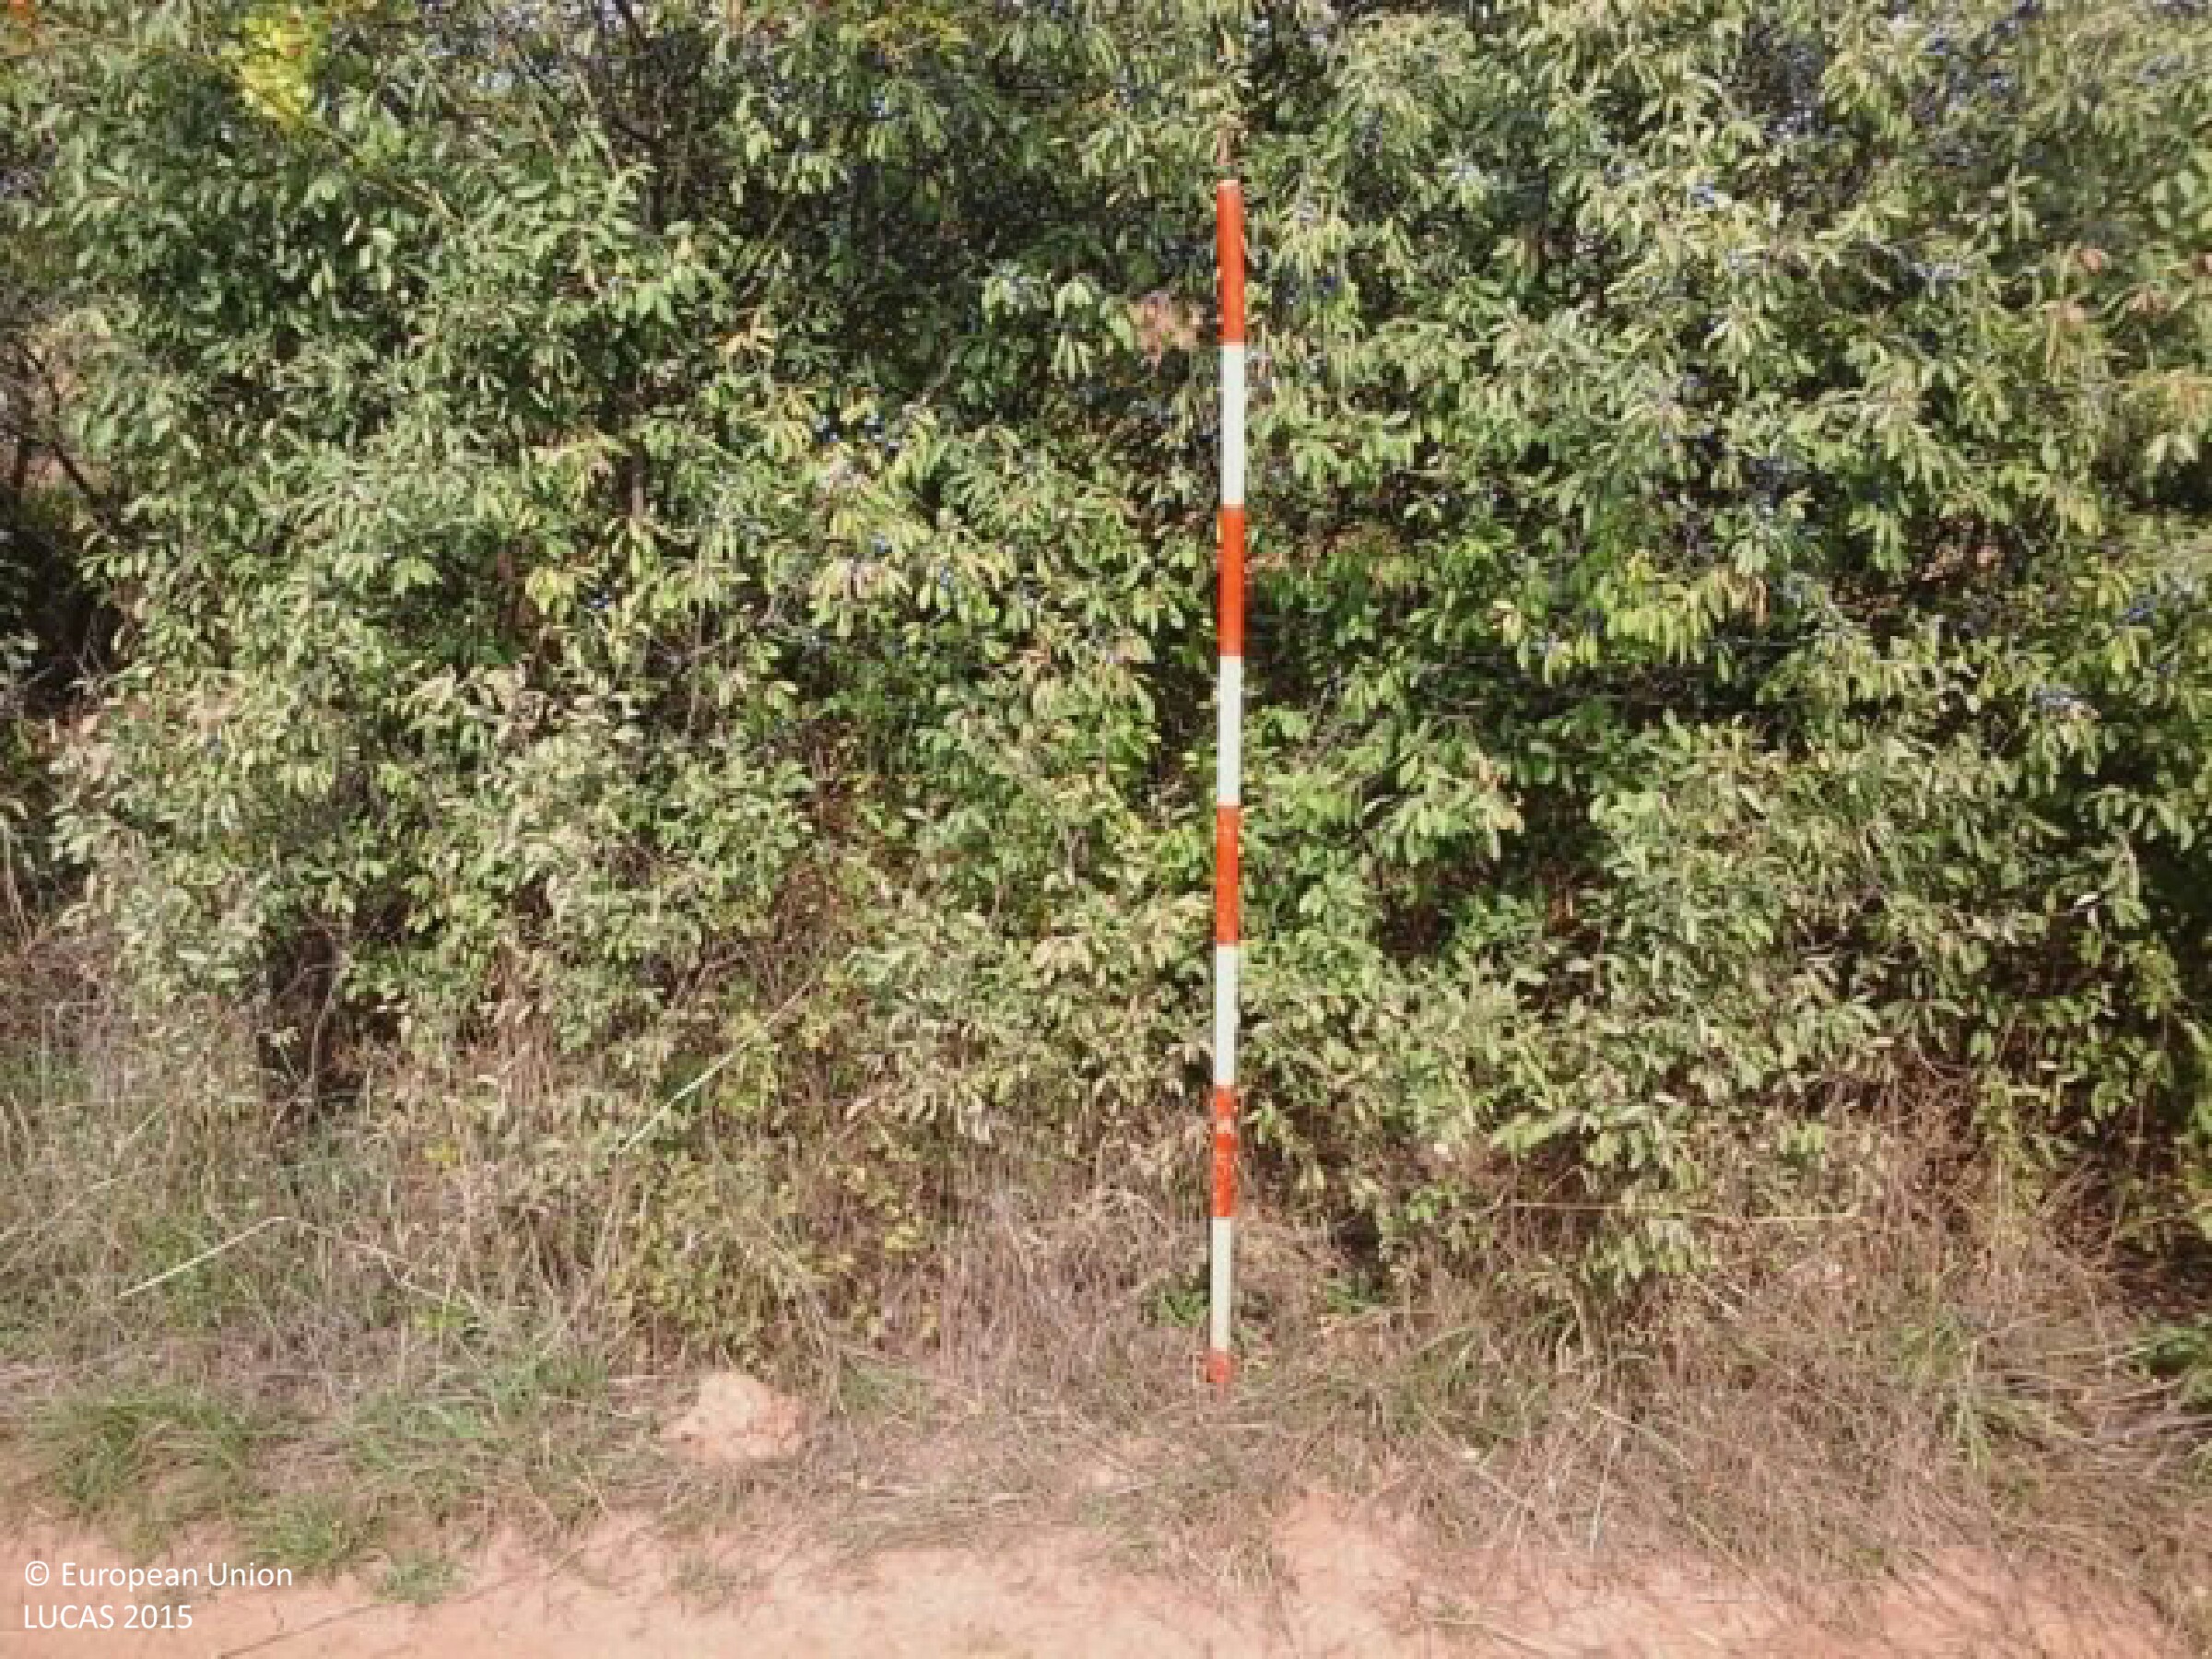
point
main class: Shrubland
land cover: Shrubland without tree cover
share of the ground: > 75 %
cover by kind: herbaceous plants 85 %, shrubs 15 %
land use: Agriculture (excluding fallow land and kitchen gardens)
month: September
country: HU
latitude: 47.7673
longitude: 19.8055
